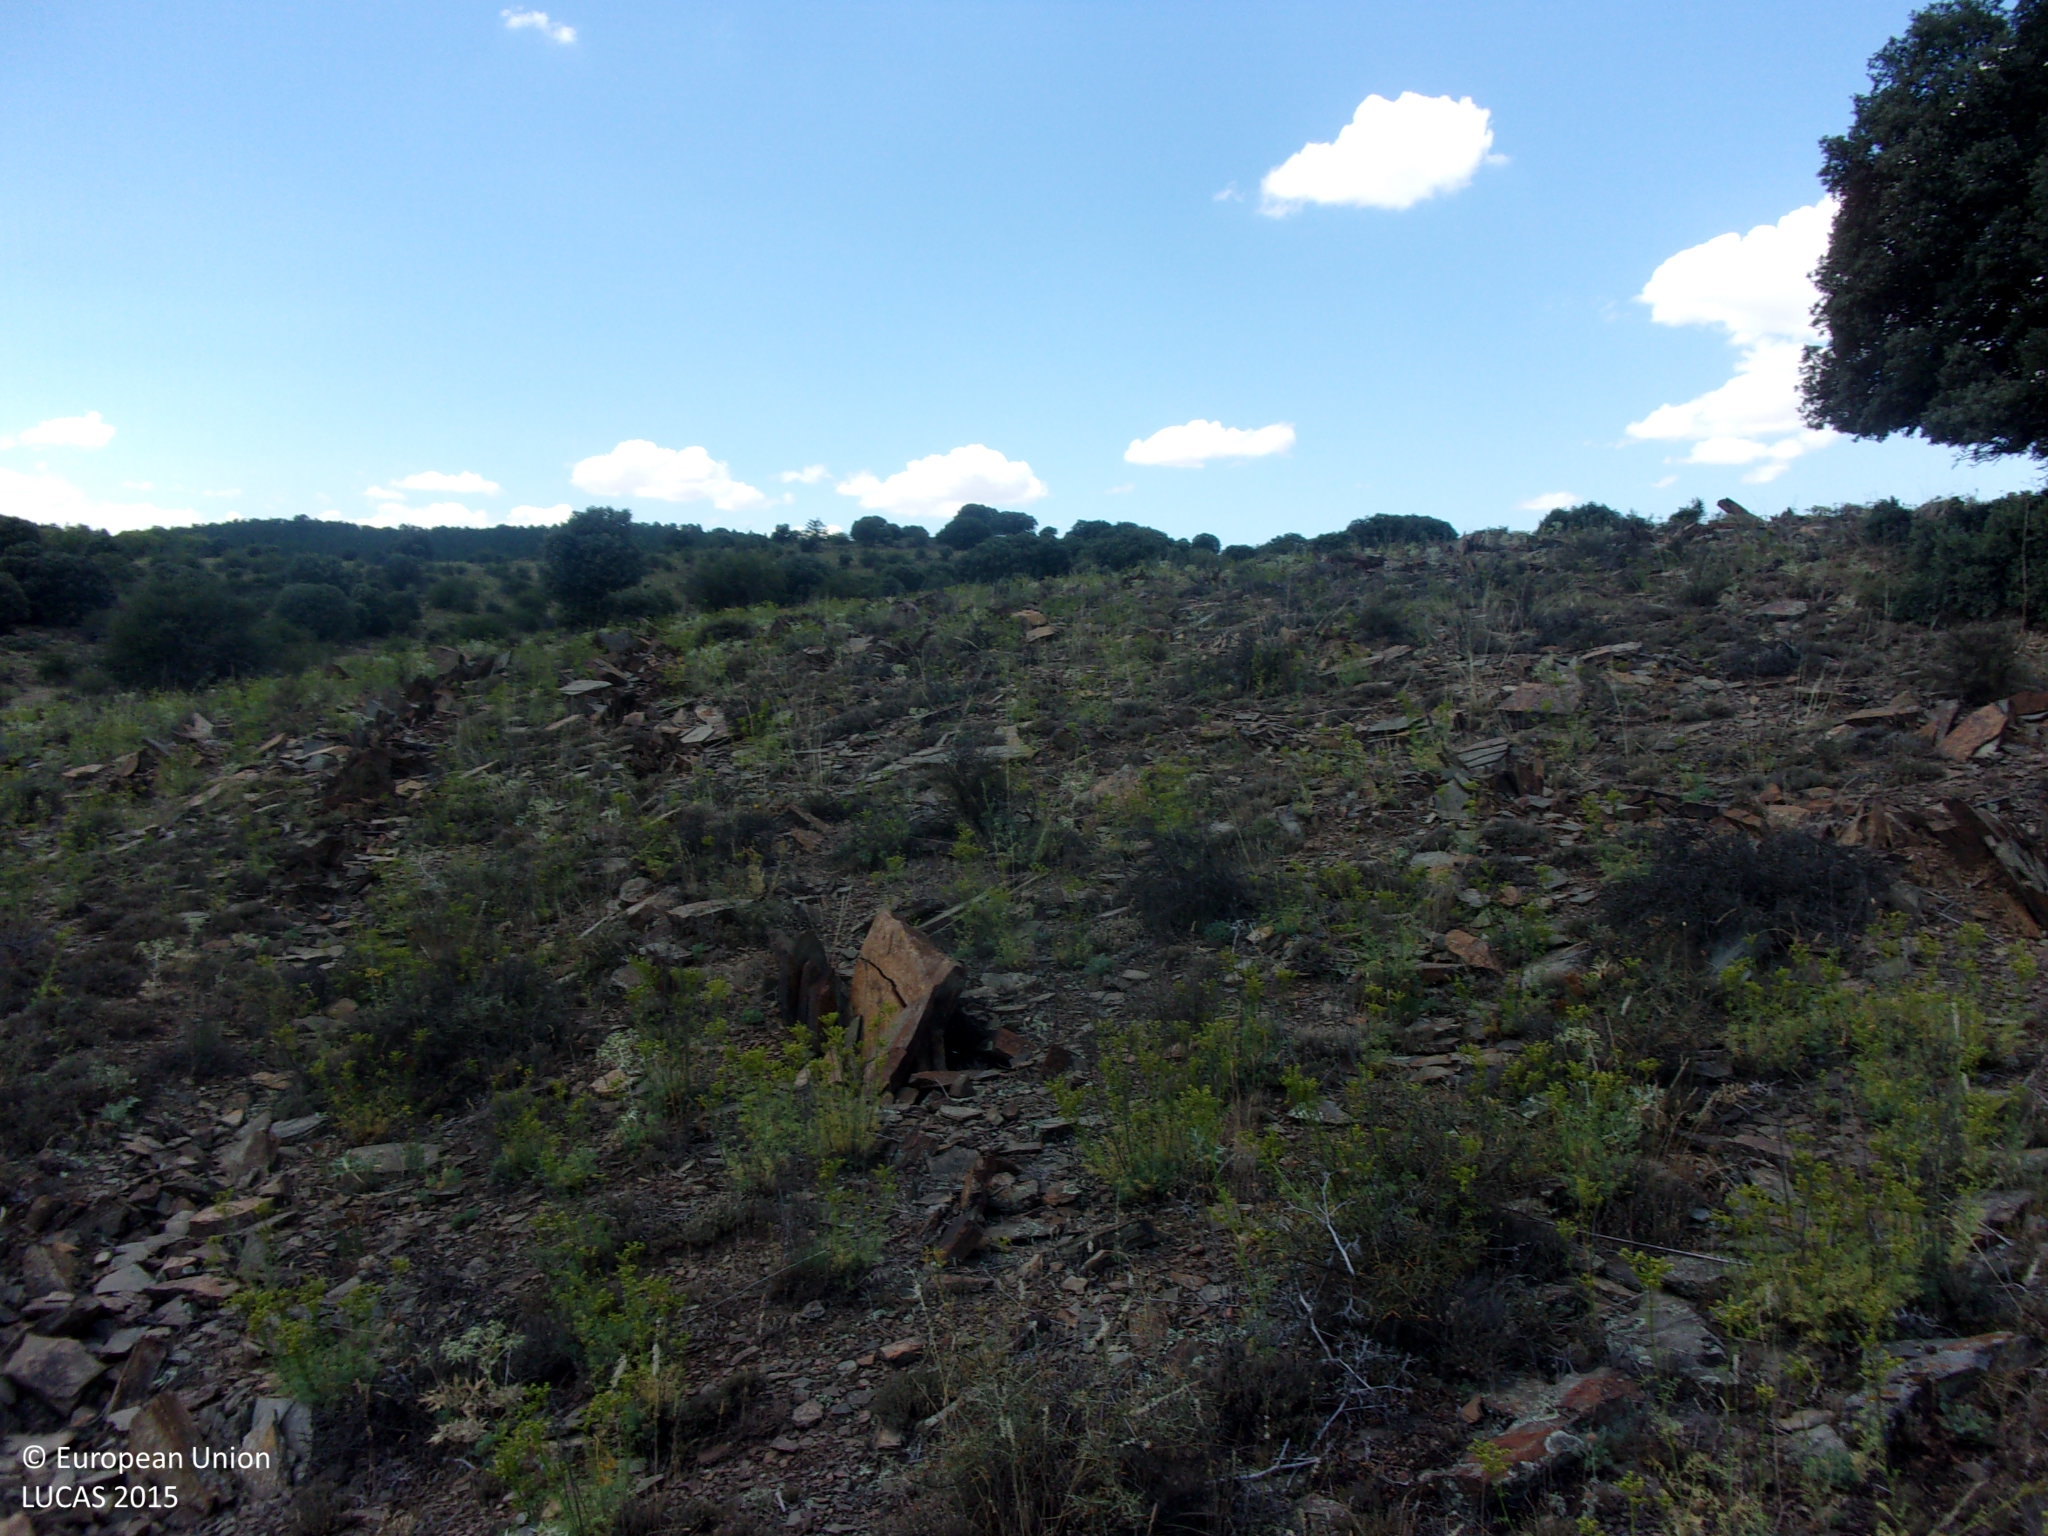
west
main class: Shrubland
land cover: Shrubland with sparse tree cover
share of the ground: > 75 %
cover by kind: shrubs 65 %, consolidated bare surface 20 %, herbaceous plants 10 %, broadleaved forest trees 5 %
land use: Semi-natural and natural areas not in use
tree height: < 5 m
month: July
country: ES
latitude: 40.9577
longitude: -1.3412
